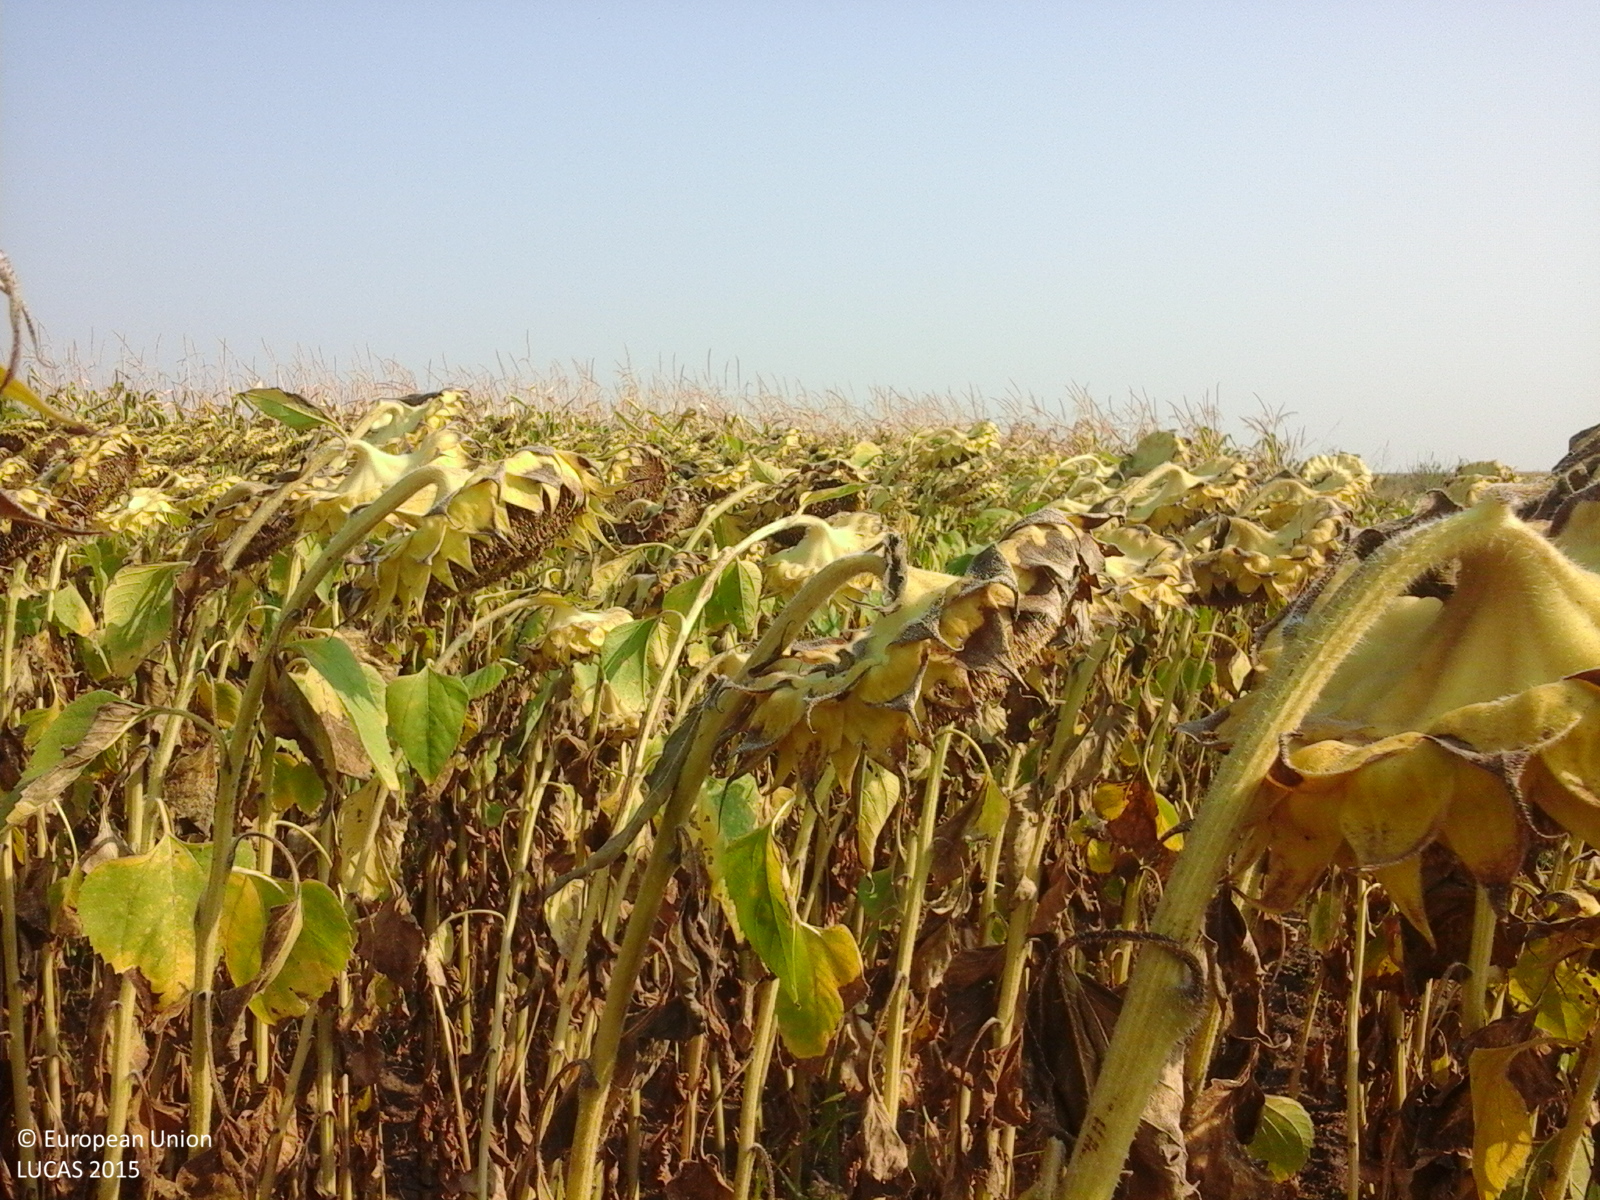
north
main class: Cropland
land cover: Sunflower
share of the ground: > 75 %
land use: Agriculture (excluding fallow land and kitchen gardens)
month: August
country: RO
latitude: 43.9333
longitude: 23.2616
